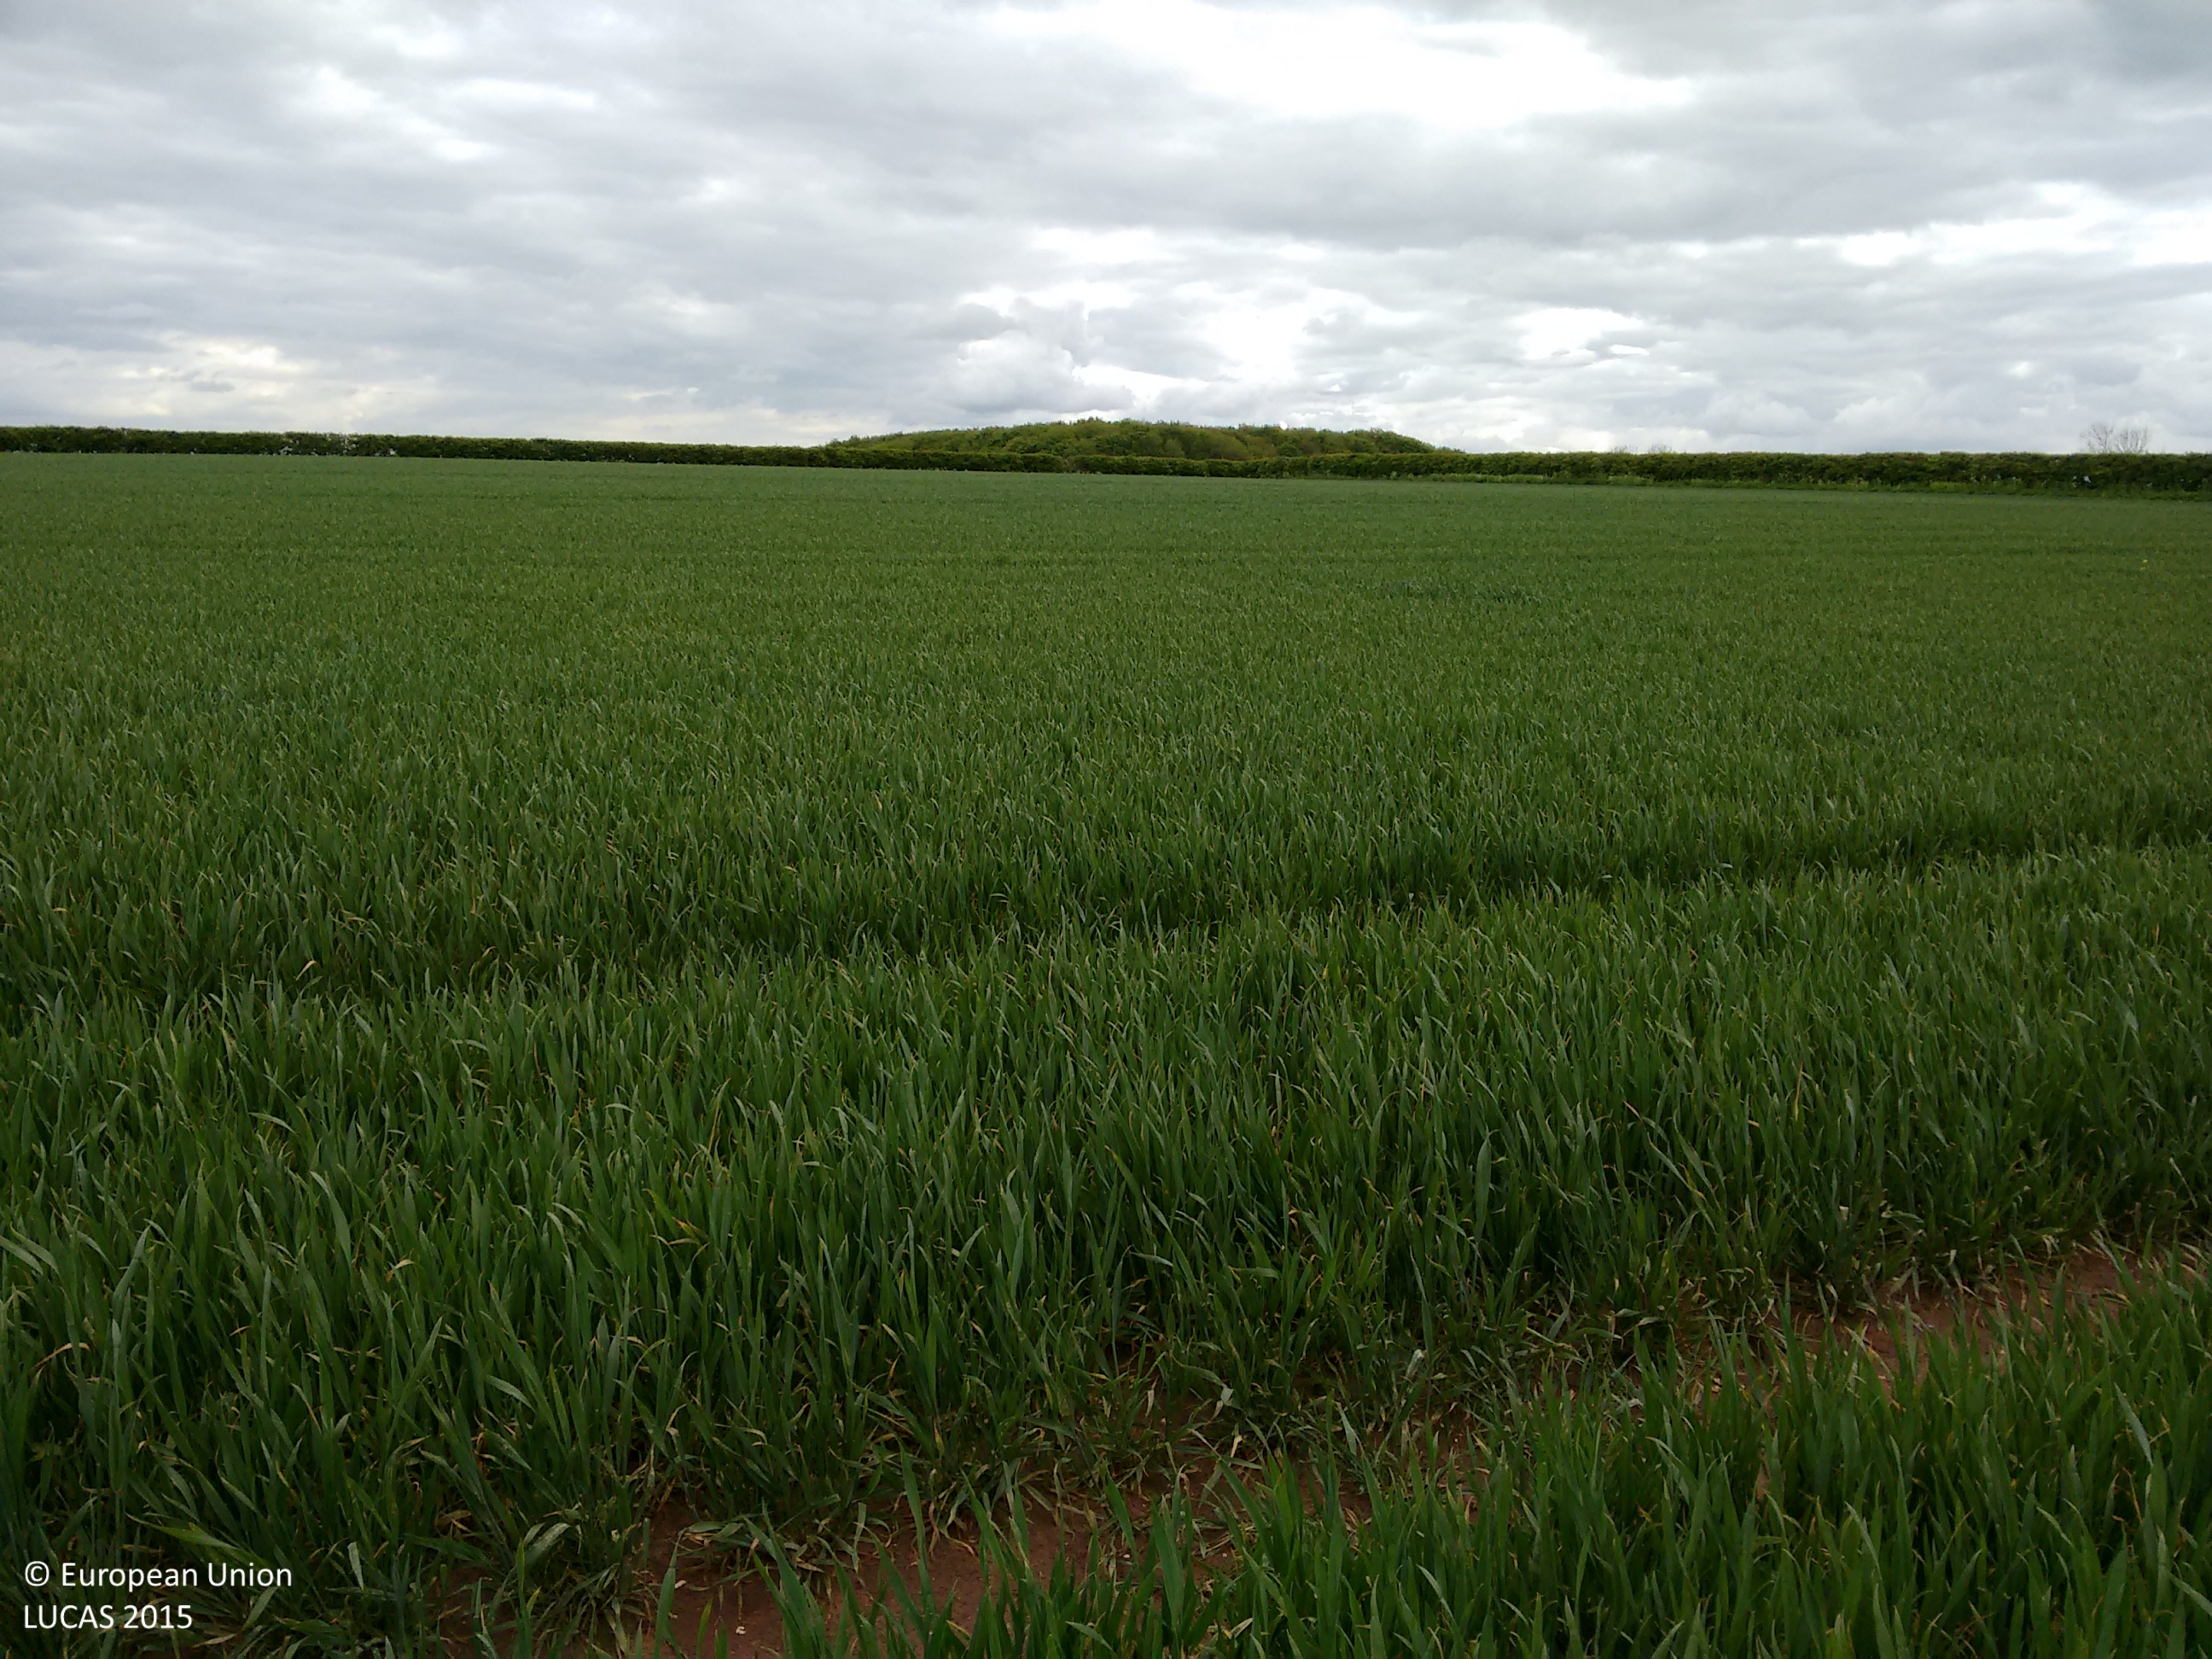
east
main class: Cropland
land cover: Common wheat
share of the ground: > 75 %
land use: Agriculture (excluding fallow land and kitchen gardens)
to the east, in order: Common wheat; Grass margins; Managed hedges; Grass margins; Tracks; Grass margins; Common wheat
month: May
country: GB
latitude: 53.5128
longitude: -0.2130
